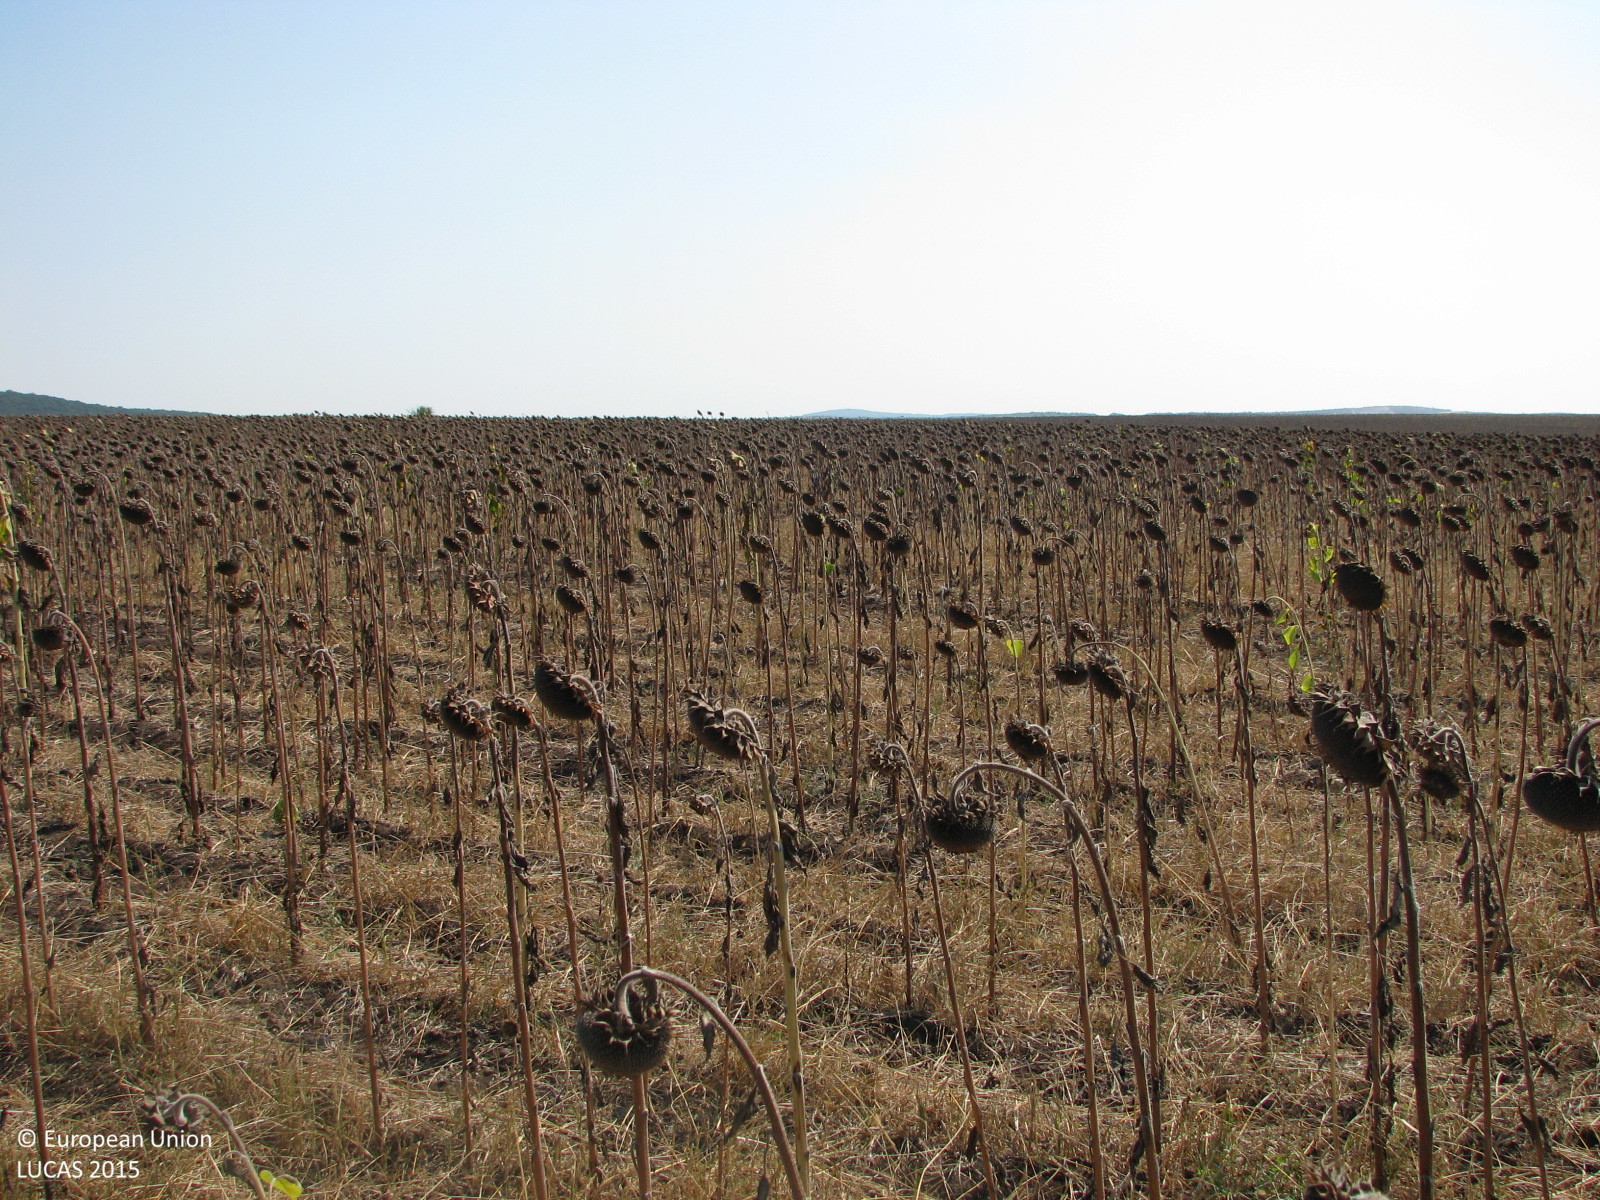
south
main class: Cropland
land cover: Sunflower
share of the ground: 50 - 75 %
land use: Agriculture (excluding fallow land and kitchen gardens)
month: September
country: BG
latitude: 42.3669
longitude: 26.7691
